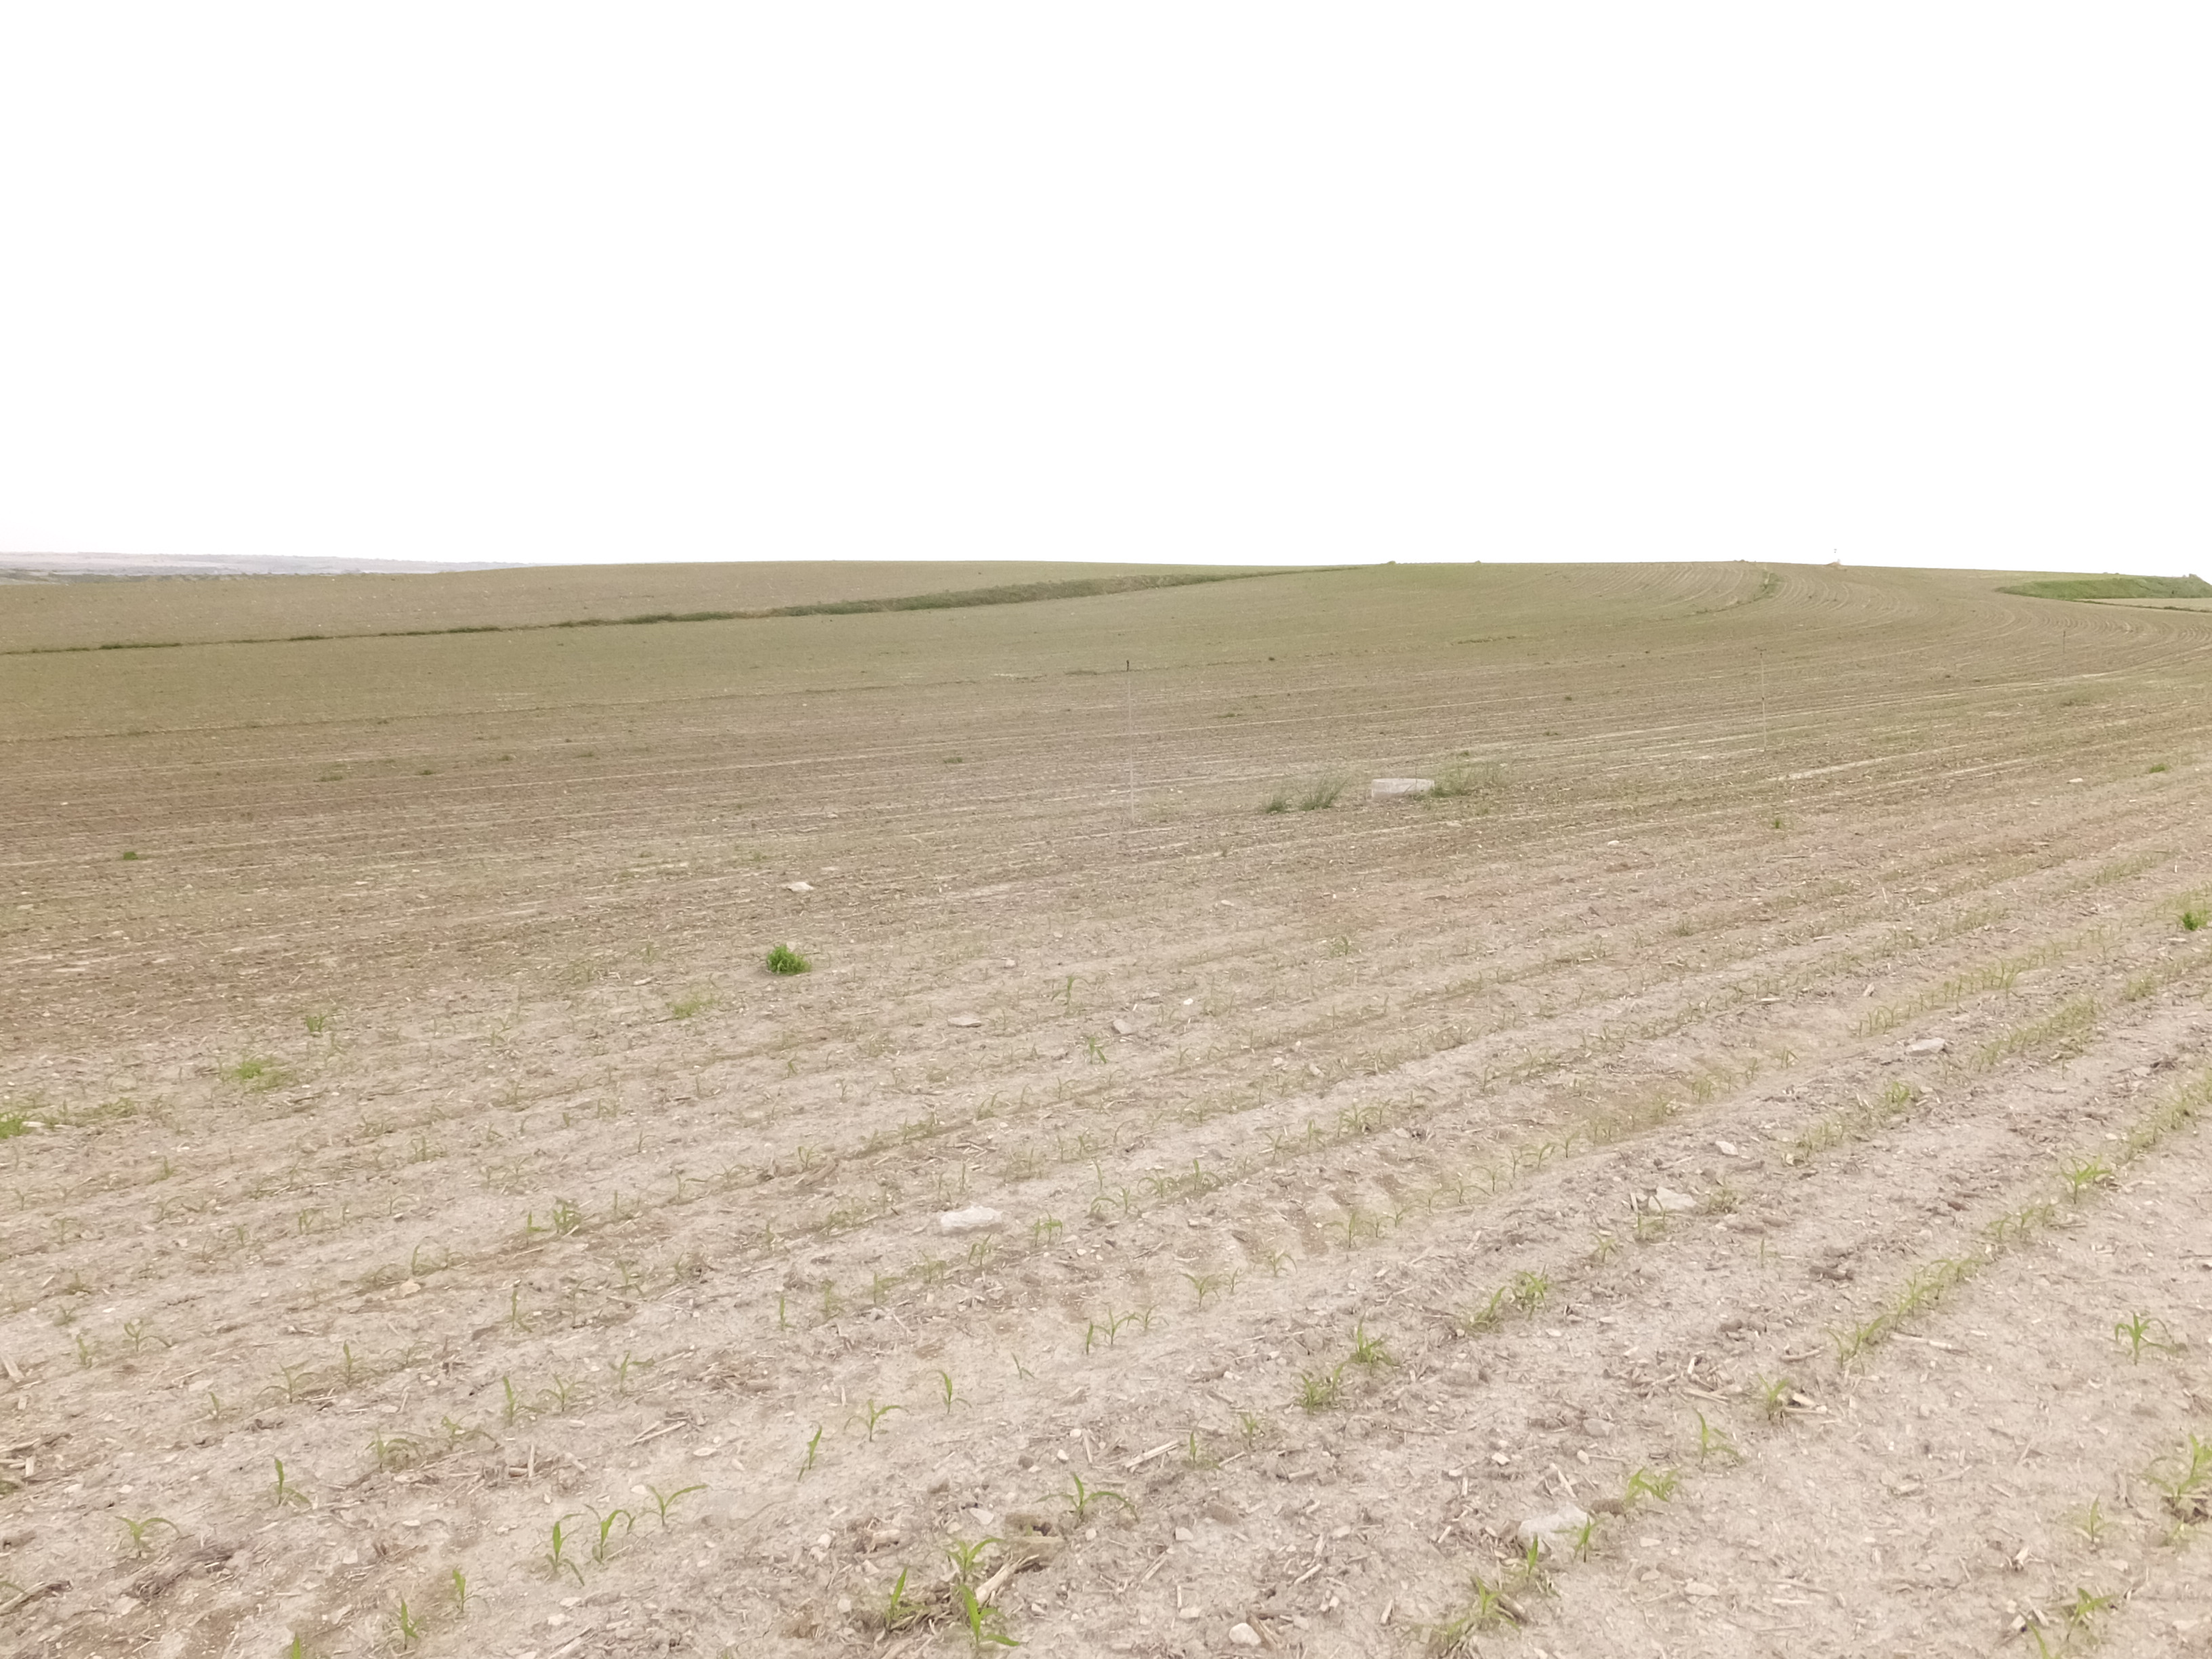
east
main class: Cropland
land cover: Maize
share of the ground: < 10 %
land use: Agriculture (excluding fallow land and kitchen gardens)
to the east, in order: Maize; Grass margins; Maize
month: May
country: ES
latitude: 41.5454
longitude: -0.1214
